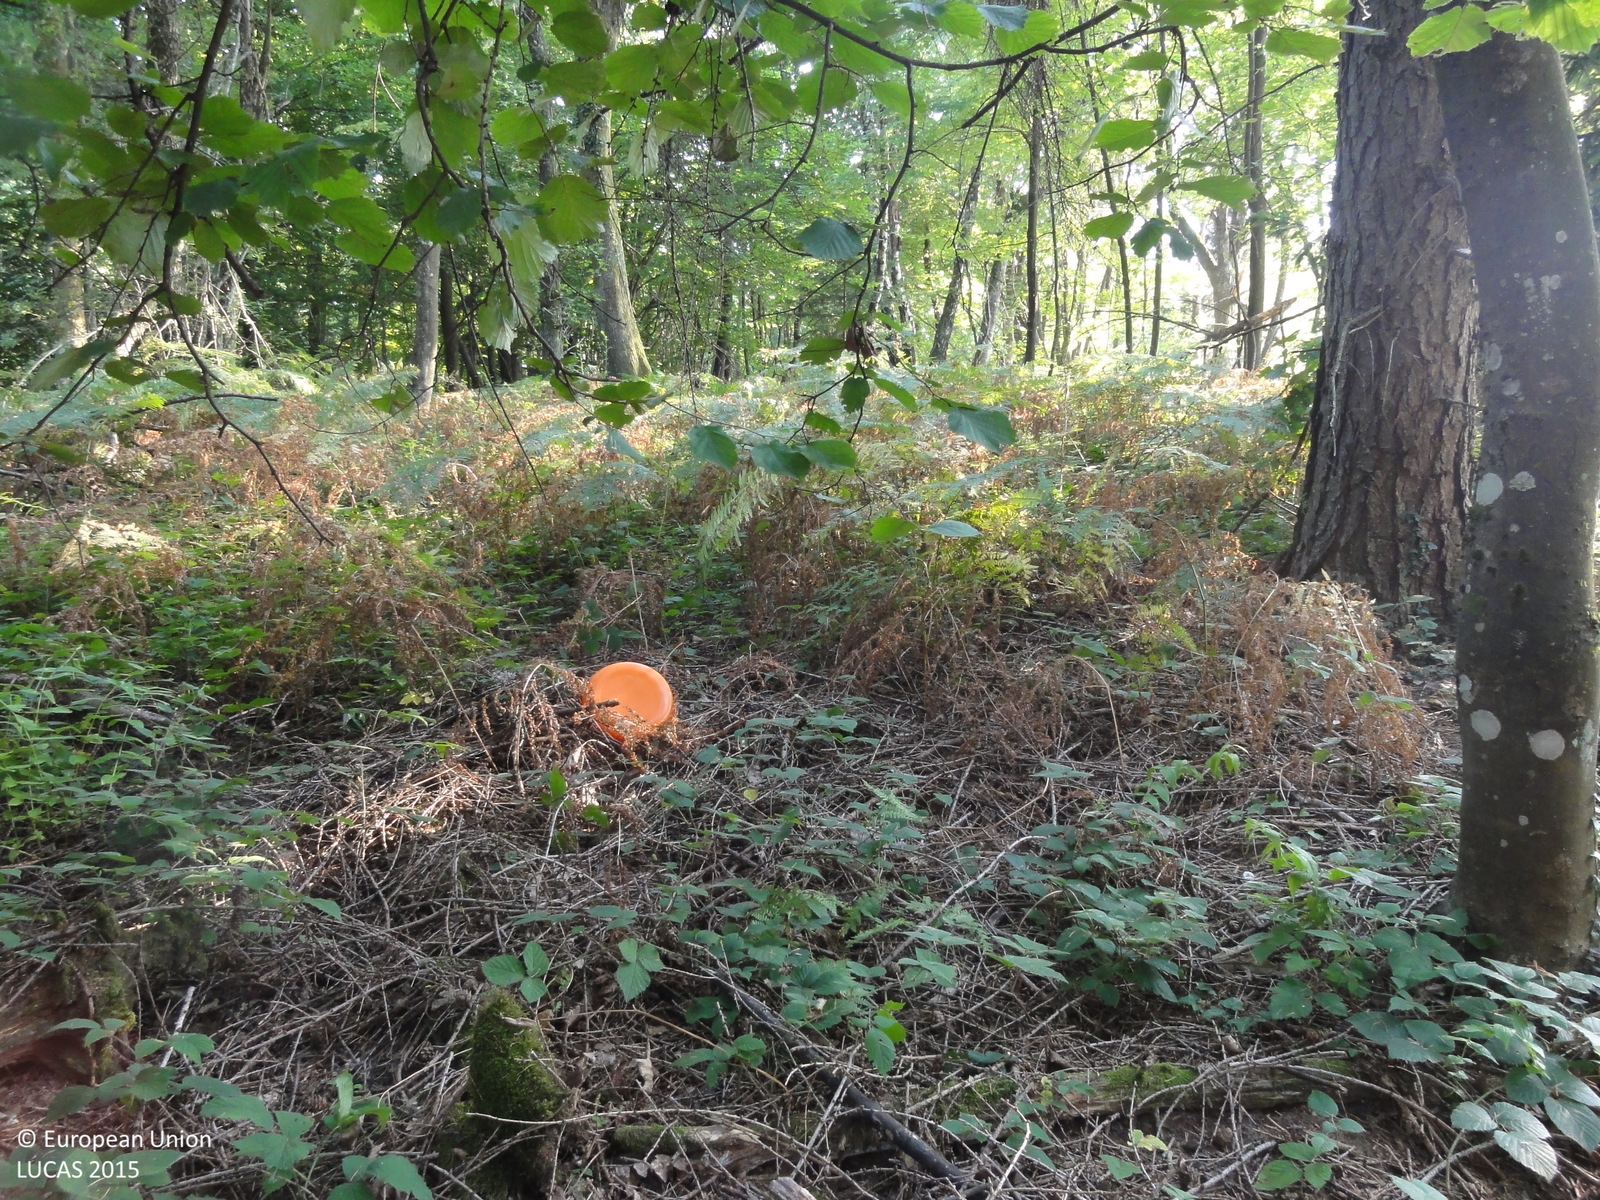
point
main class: Woodland
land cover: Spruce dominated mixed woodland
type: mesophytic deciduous forest
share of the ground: > 75 %
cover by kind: broadleaved forest trees 60 %, coniferous forest trees 40 %
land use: Forestry
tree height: > 5 m
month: August
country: SI
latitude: 45.8179
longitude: 15.0287
